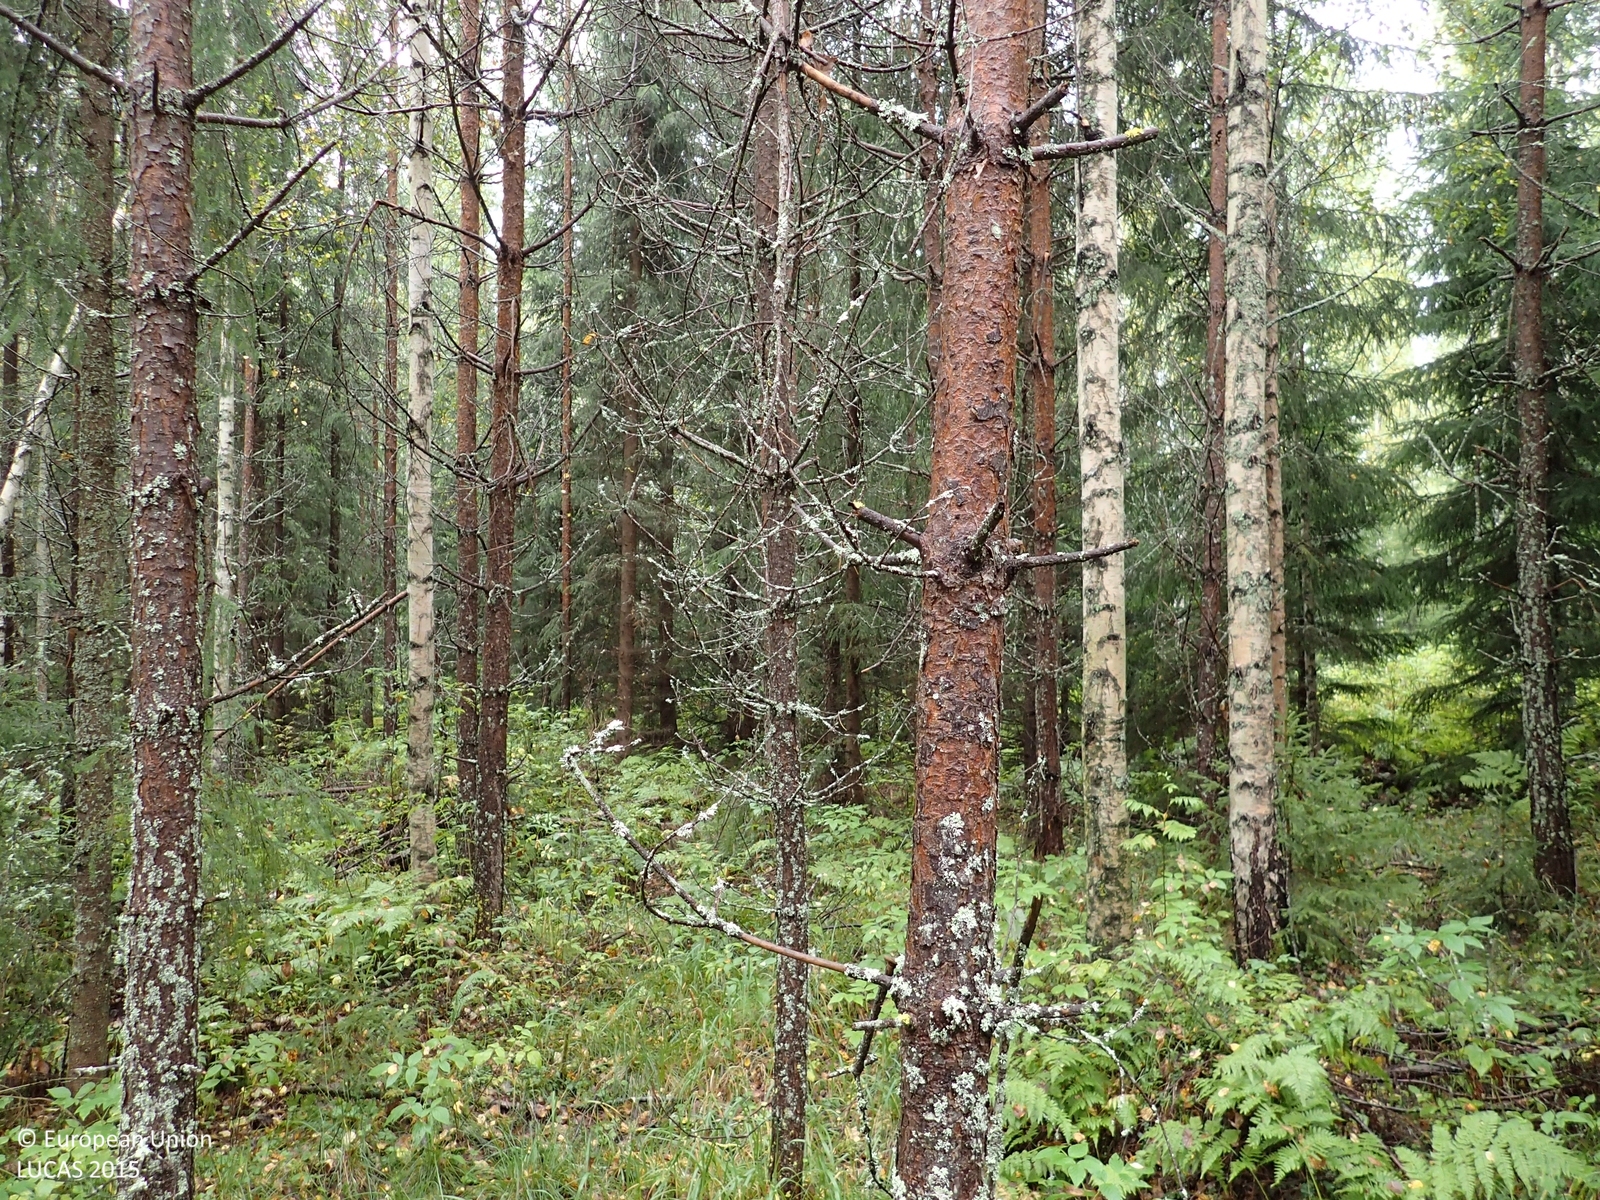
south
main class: Woodland
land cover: Other mixed woodland
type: boreal forest
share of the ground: > 75 %
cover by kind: coniferous forest trees 55 %, broadleaved forest trees 20 %, herbaceous plants 20 %, lichens and mosses 5 %
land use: Forestry
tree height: > 5 m
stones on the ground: < 10 %
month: September
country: FI
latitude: 63.1190
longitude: 25.7936
